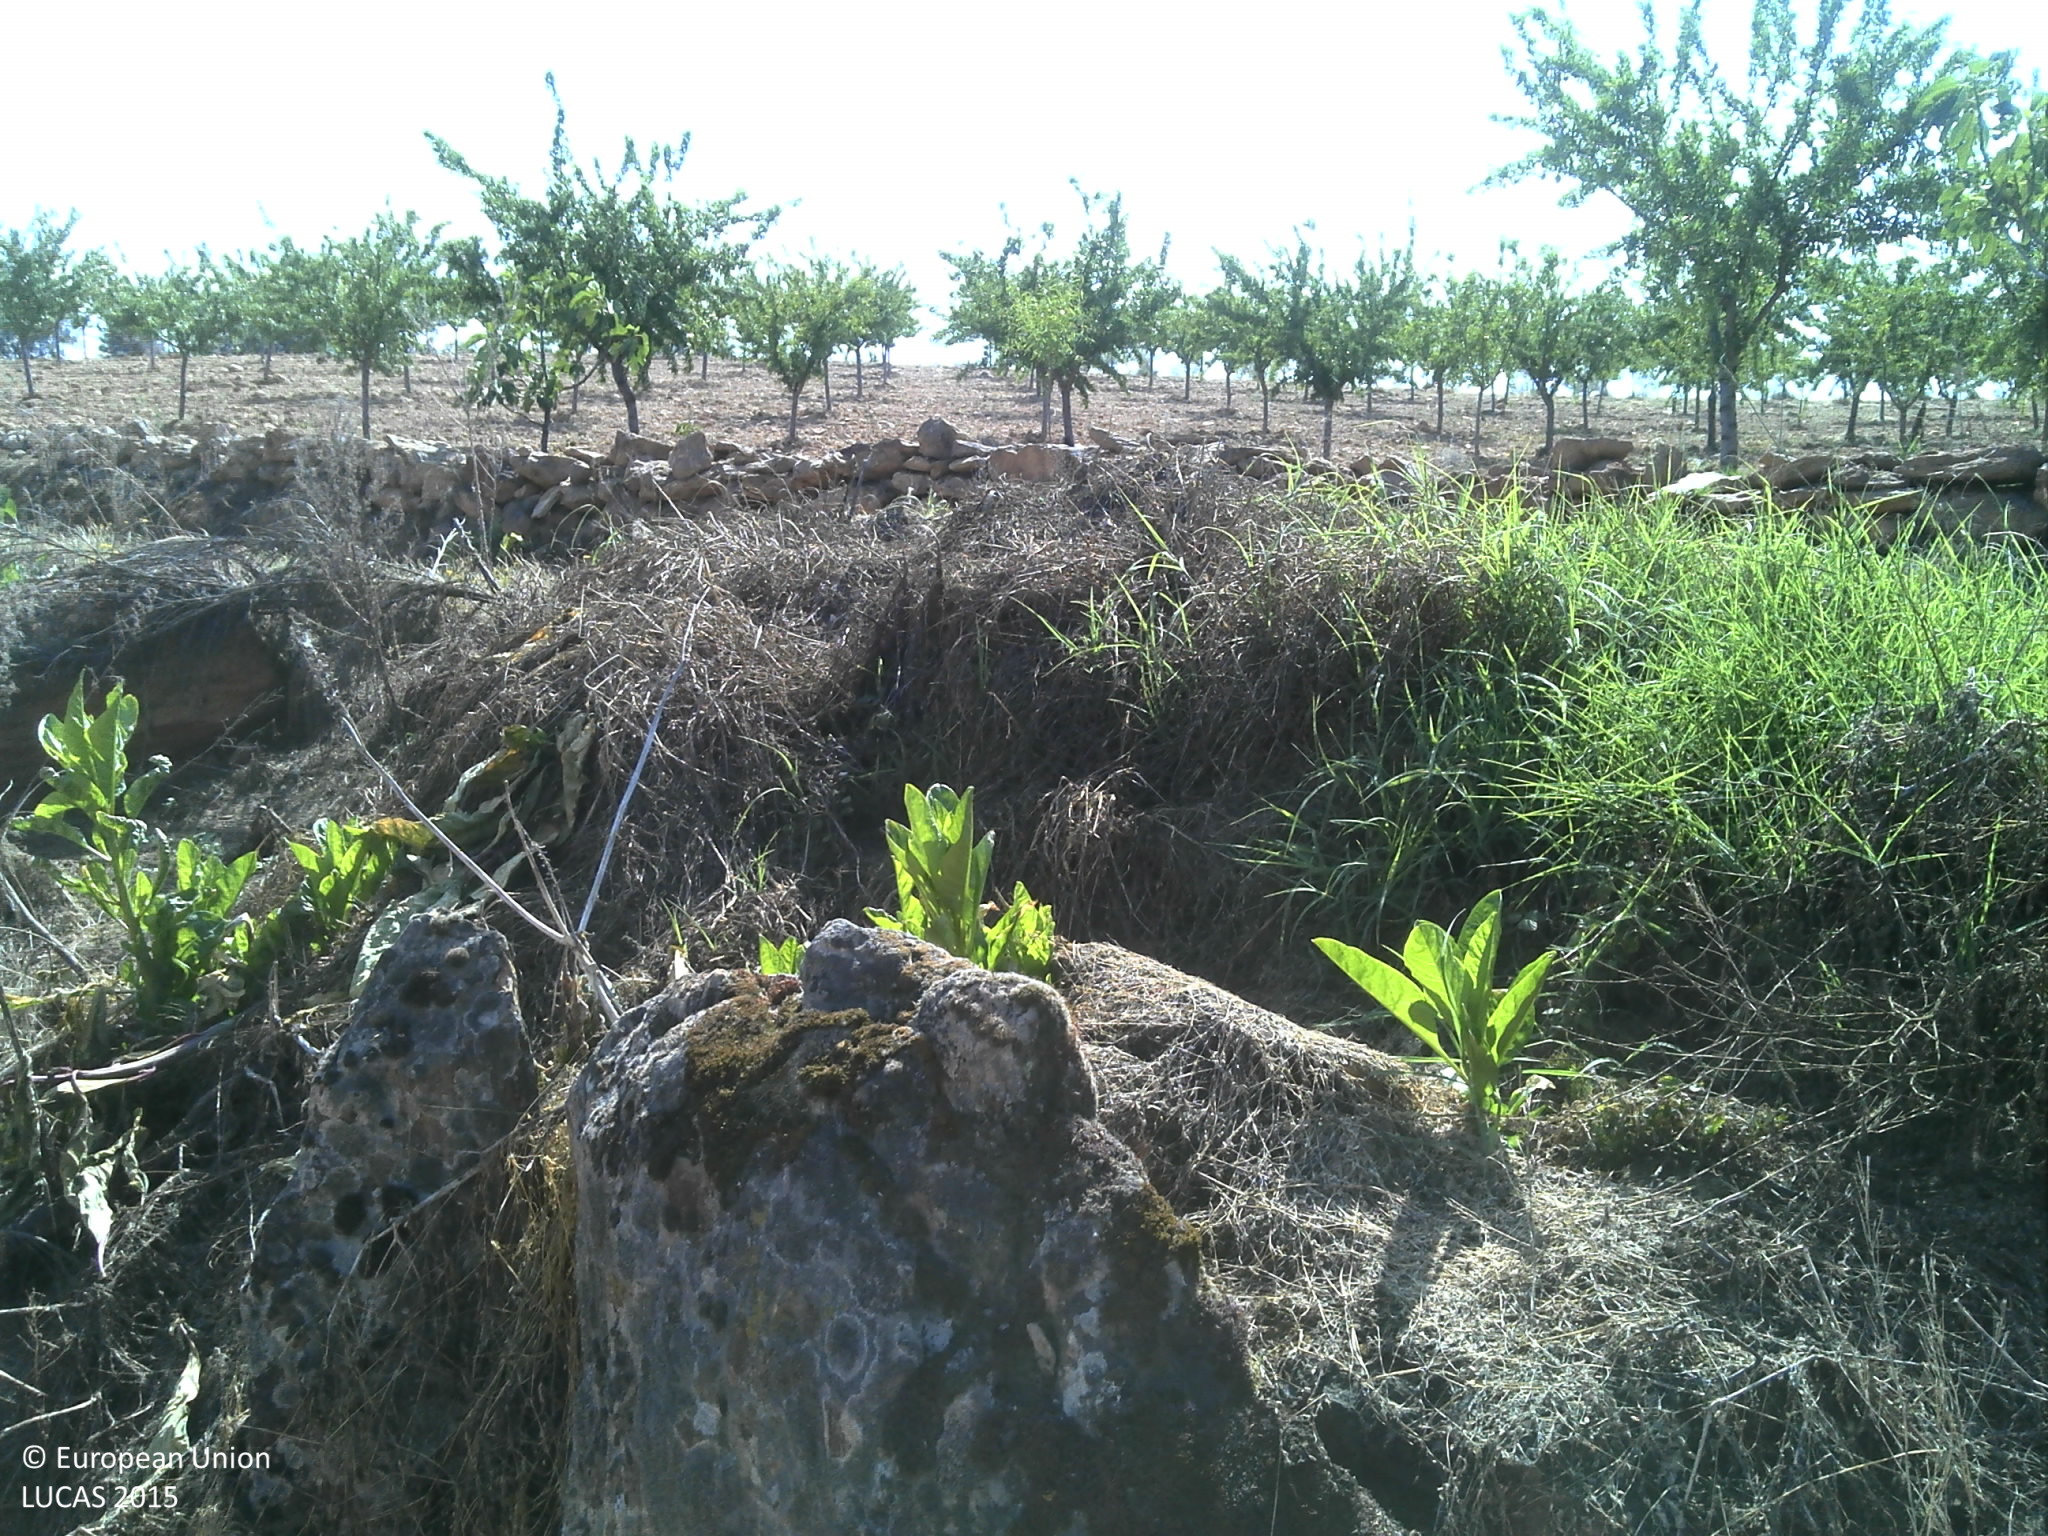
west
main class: Cropland
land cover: Olive groves
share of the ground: 10 - 25 %
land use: Agriculture (excluding fallow land and kitchen gardens)
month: May
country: PT
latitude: 41.5432
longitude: -7.2761
